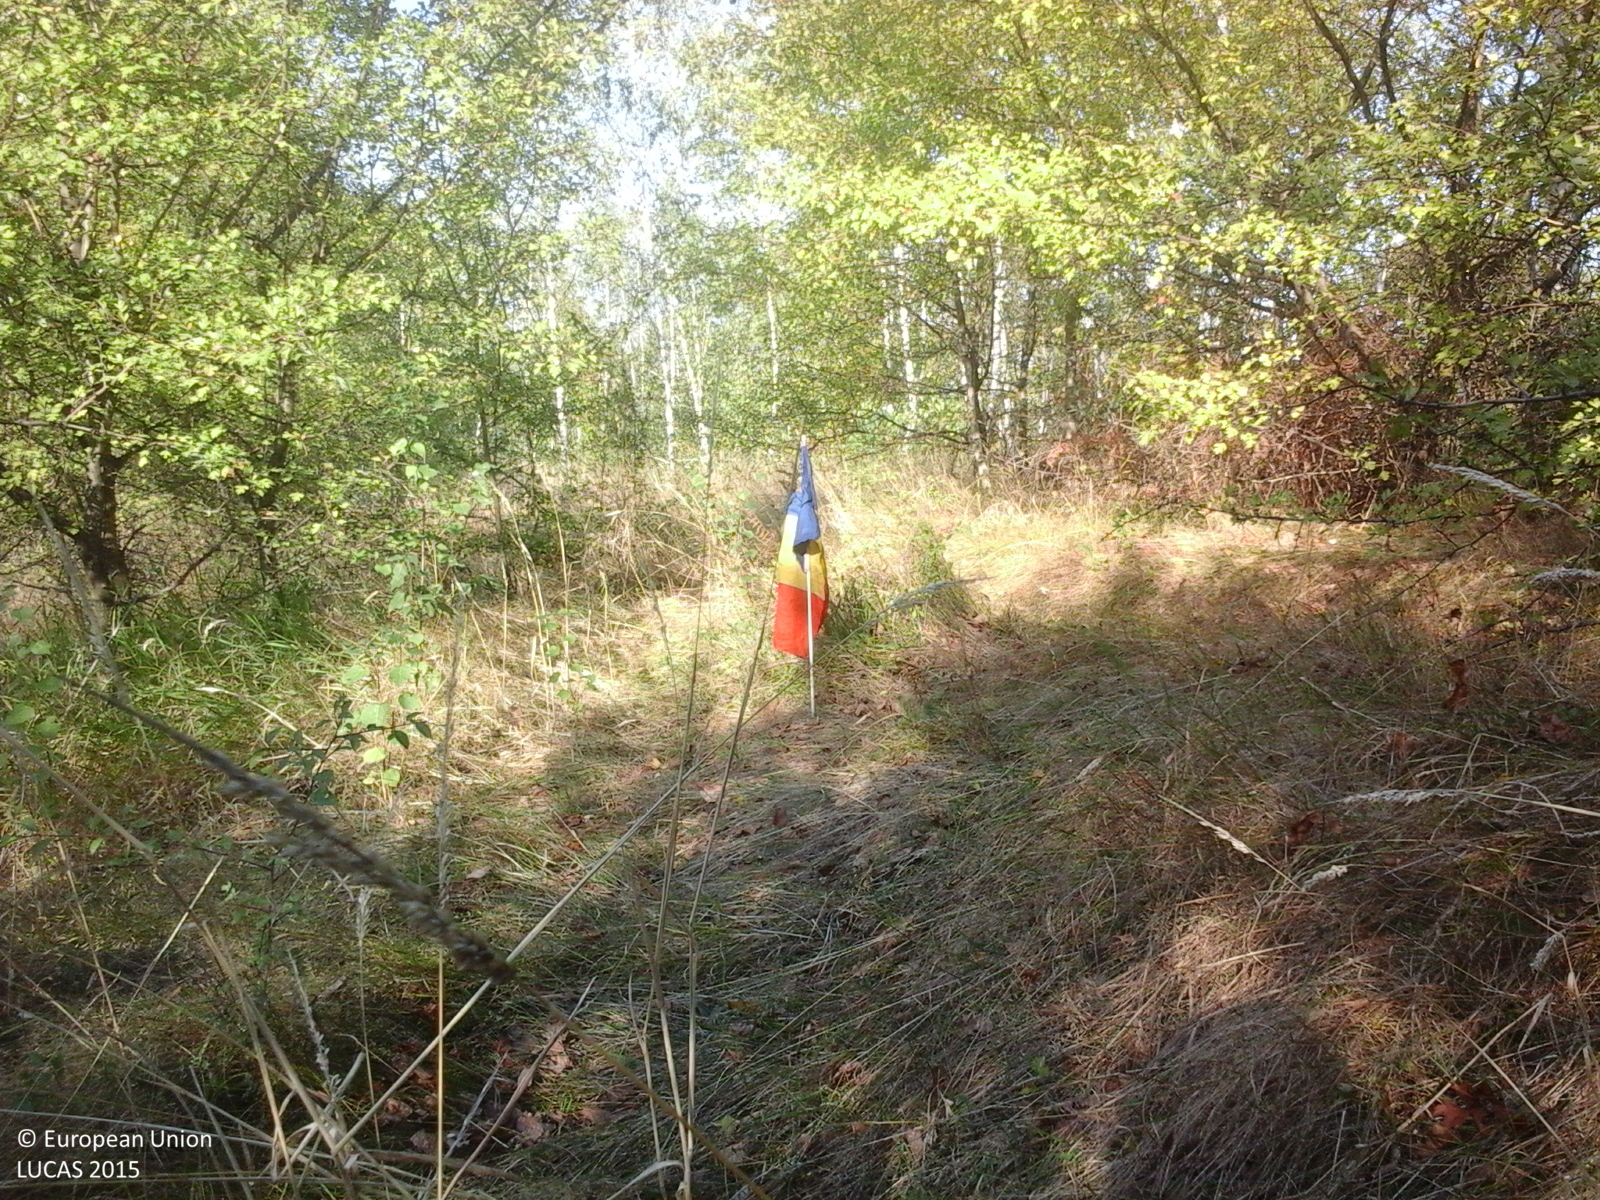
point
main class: Woodland
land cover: Broadleaved woodland
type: non-riverine alder, birch or aspen forest
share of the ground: > 75 %
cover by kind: broadleaved forest trees 100 %
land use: Forestry
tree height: > 5 m
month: September
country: RO
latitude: 45.2810
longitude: 22.2404
